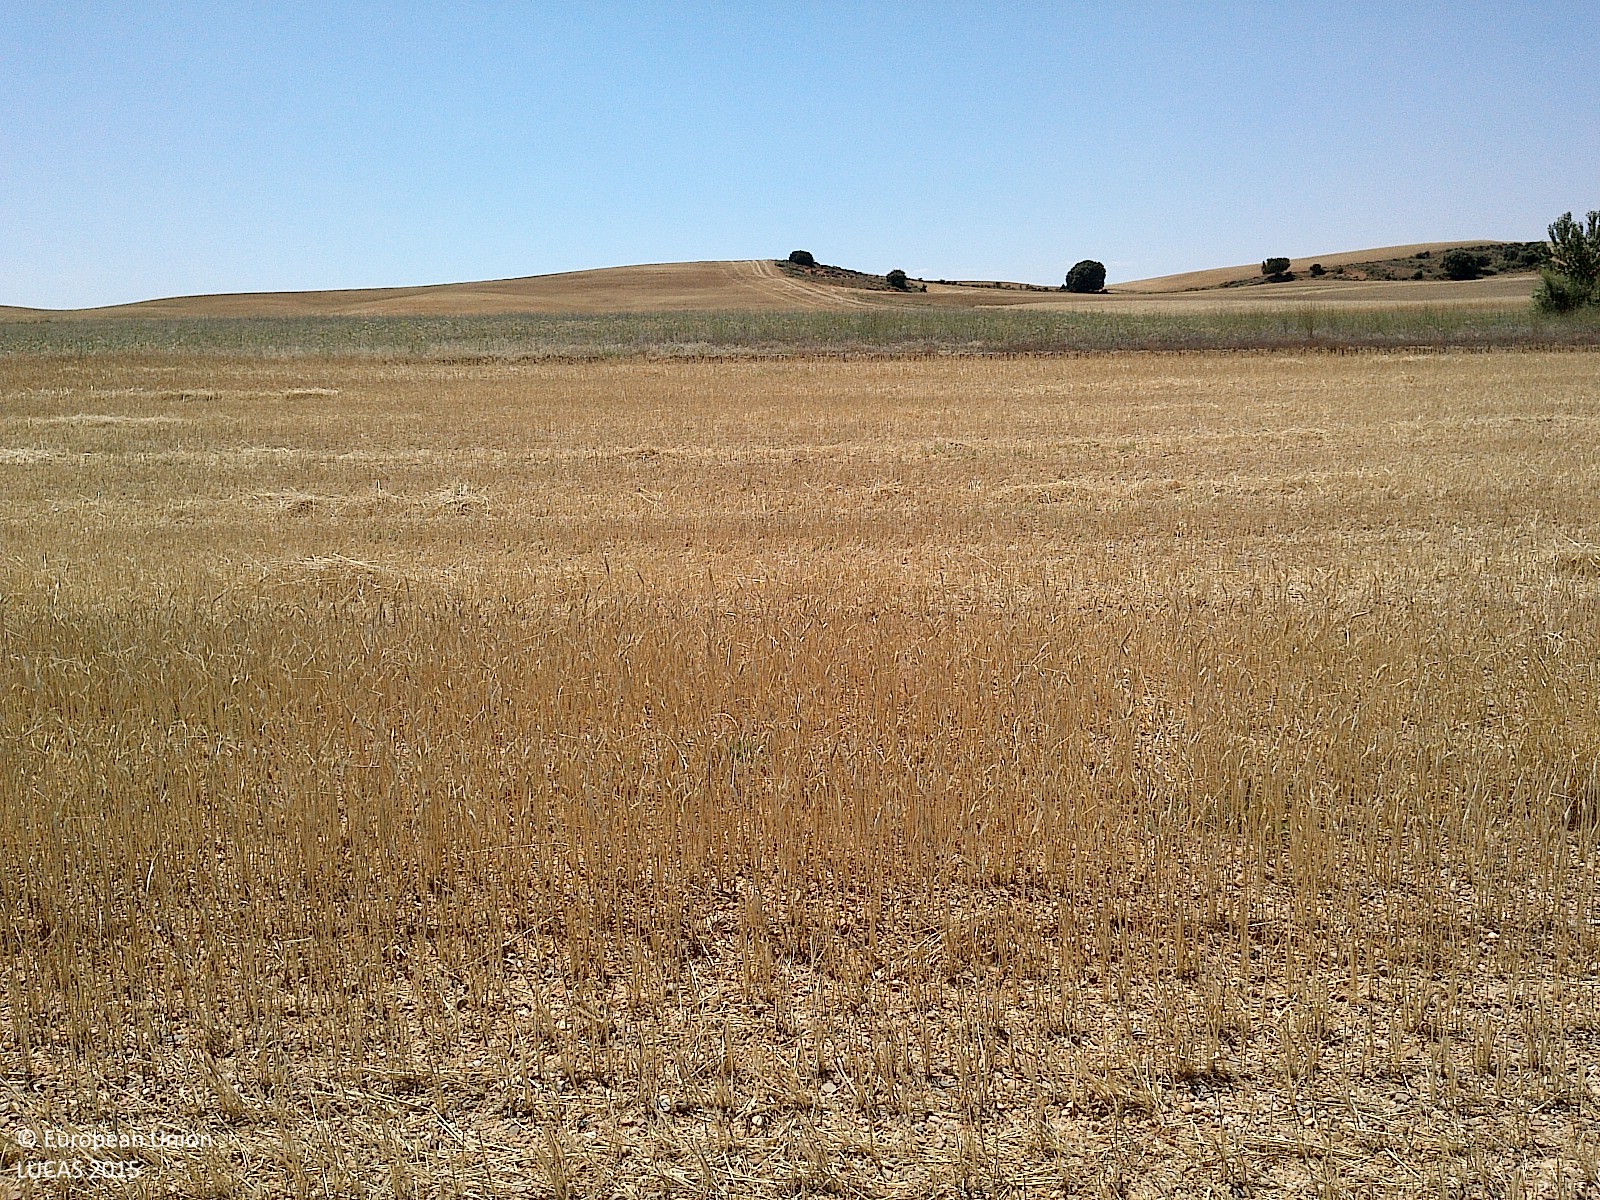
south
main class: Cropland
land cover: Common wheat
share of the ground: < 10 %
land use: Agriculture (excluding fallow land and kitchen gardens)
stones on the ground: 10 - 25 %
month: July
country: ES
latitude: 41.7411
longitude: -3.2622
